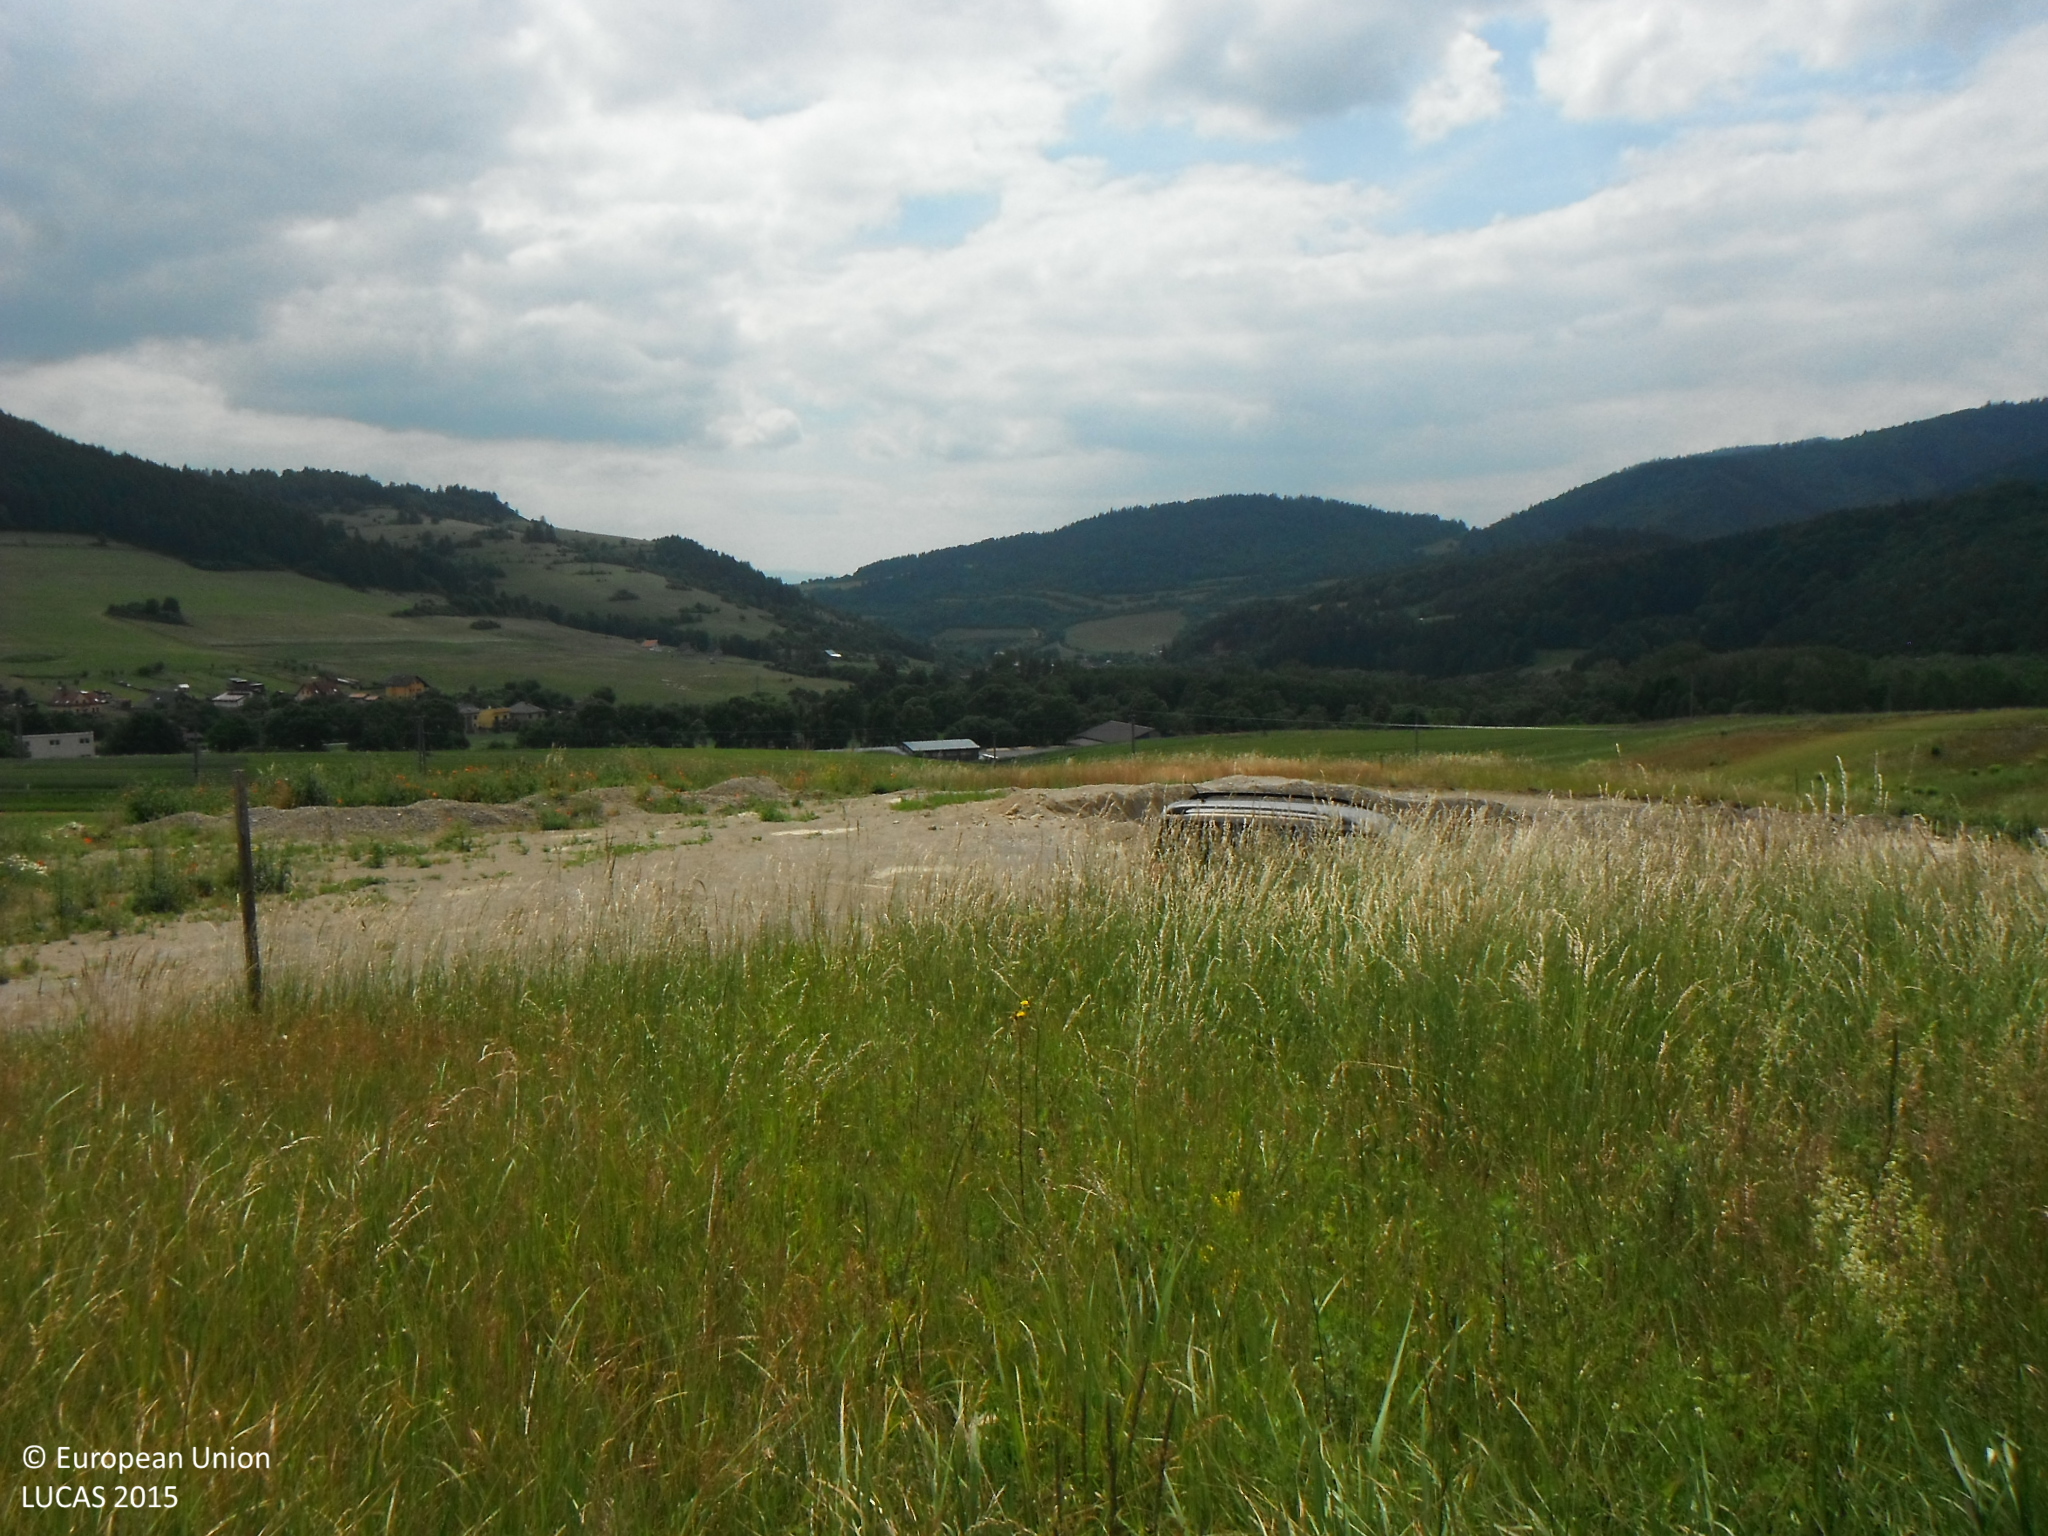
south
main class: Grassland
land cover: Grassland without tree/shrub cover
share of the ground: > 75 %
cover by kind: herbaceous plants 100 %
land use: Agriculture (excluding fallow land and kitchen gardens)
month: June
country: SK
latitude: 49.0563
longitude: 20.9478
